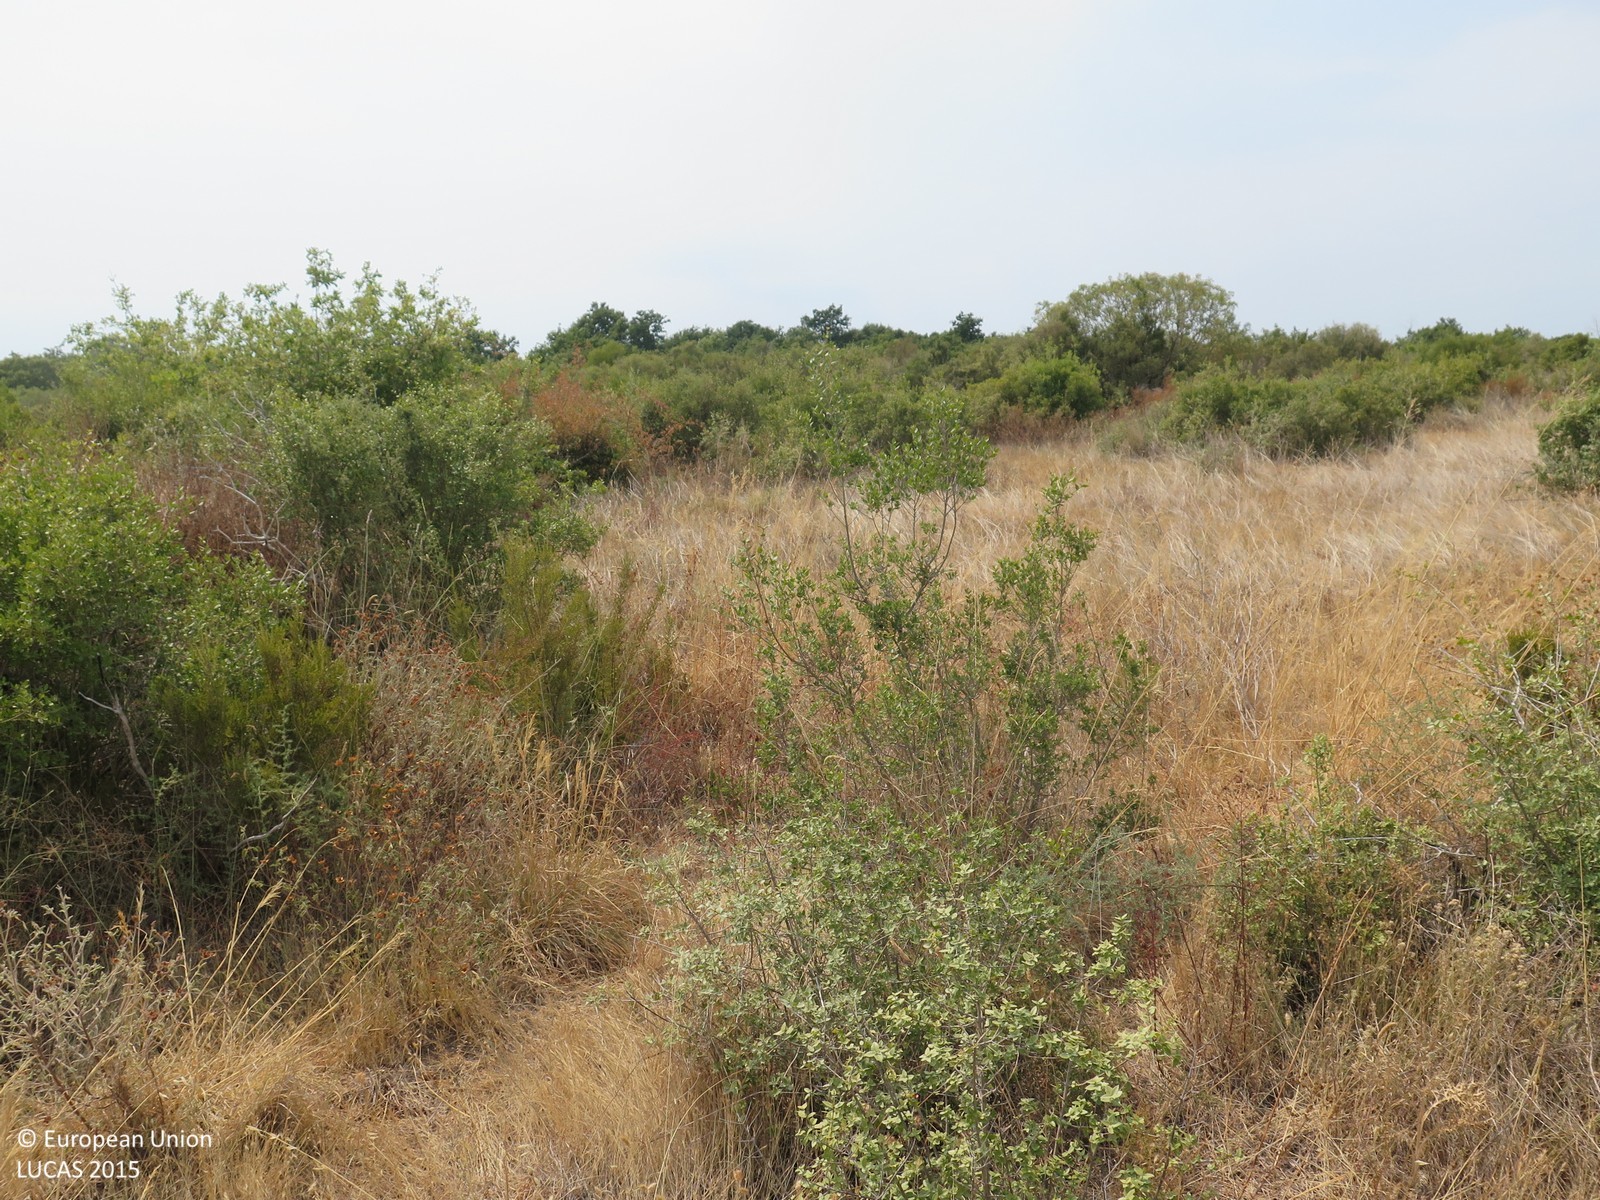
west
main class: Shrubland
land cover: Shrubland with sparse tree cover
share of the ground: > 75 %
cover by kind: shrubs 90 %, broadleaved forest trees 5 %, herbaceous plants 5 %
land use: Semi-natural and natural areas not in use
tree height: < 5 m
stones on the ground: 10 - 25 %
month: July
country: HR
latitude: 45.0035
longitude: 13.7877
